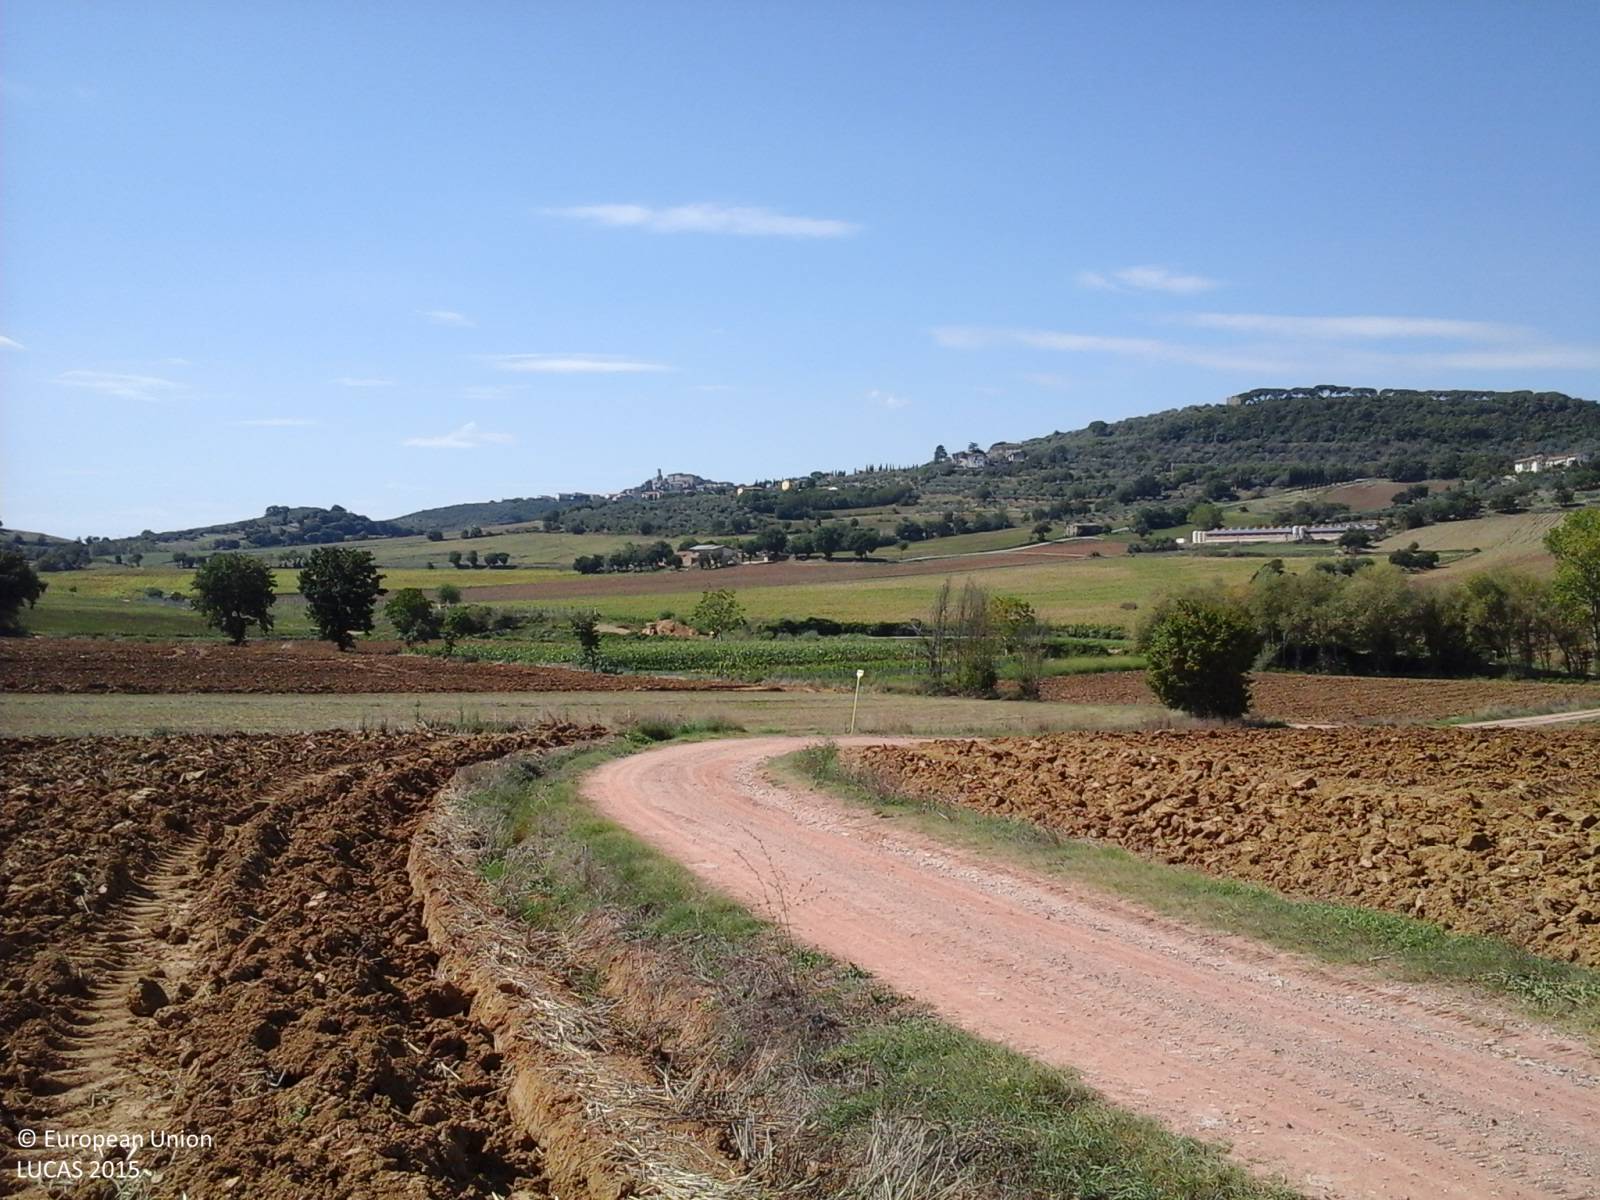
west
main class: Cropland
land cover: Durum wheat
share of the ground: < 10 %
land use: Agriculture (excluding fallow land and kitchen gardens)
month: September
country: IT
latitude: 43.0803
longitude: 12.2657
